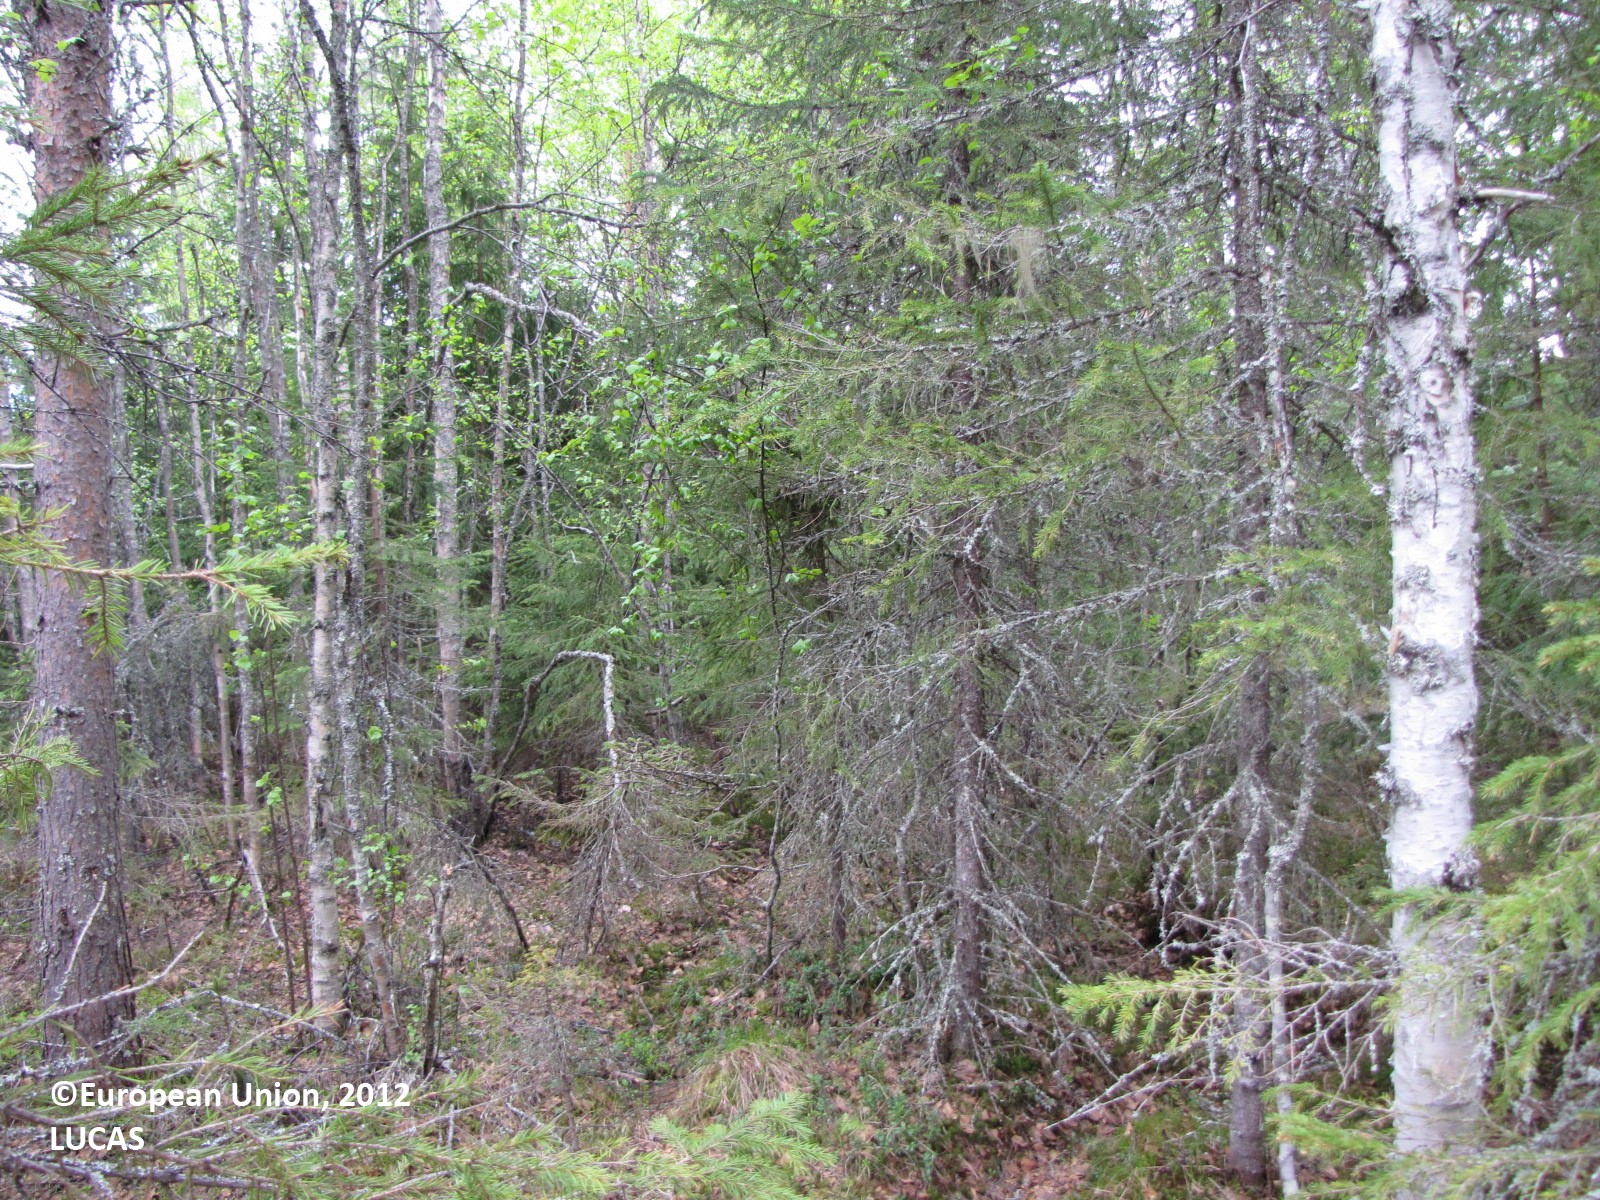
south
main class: Woodland
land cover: Other mixed woodland
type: boreal forest
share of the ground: 50 - 75 %
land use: Forestry
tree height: > 5 m
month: June
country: FI
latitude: 65.9015
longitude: 24.7405
